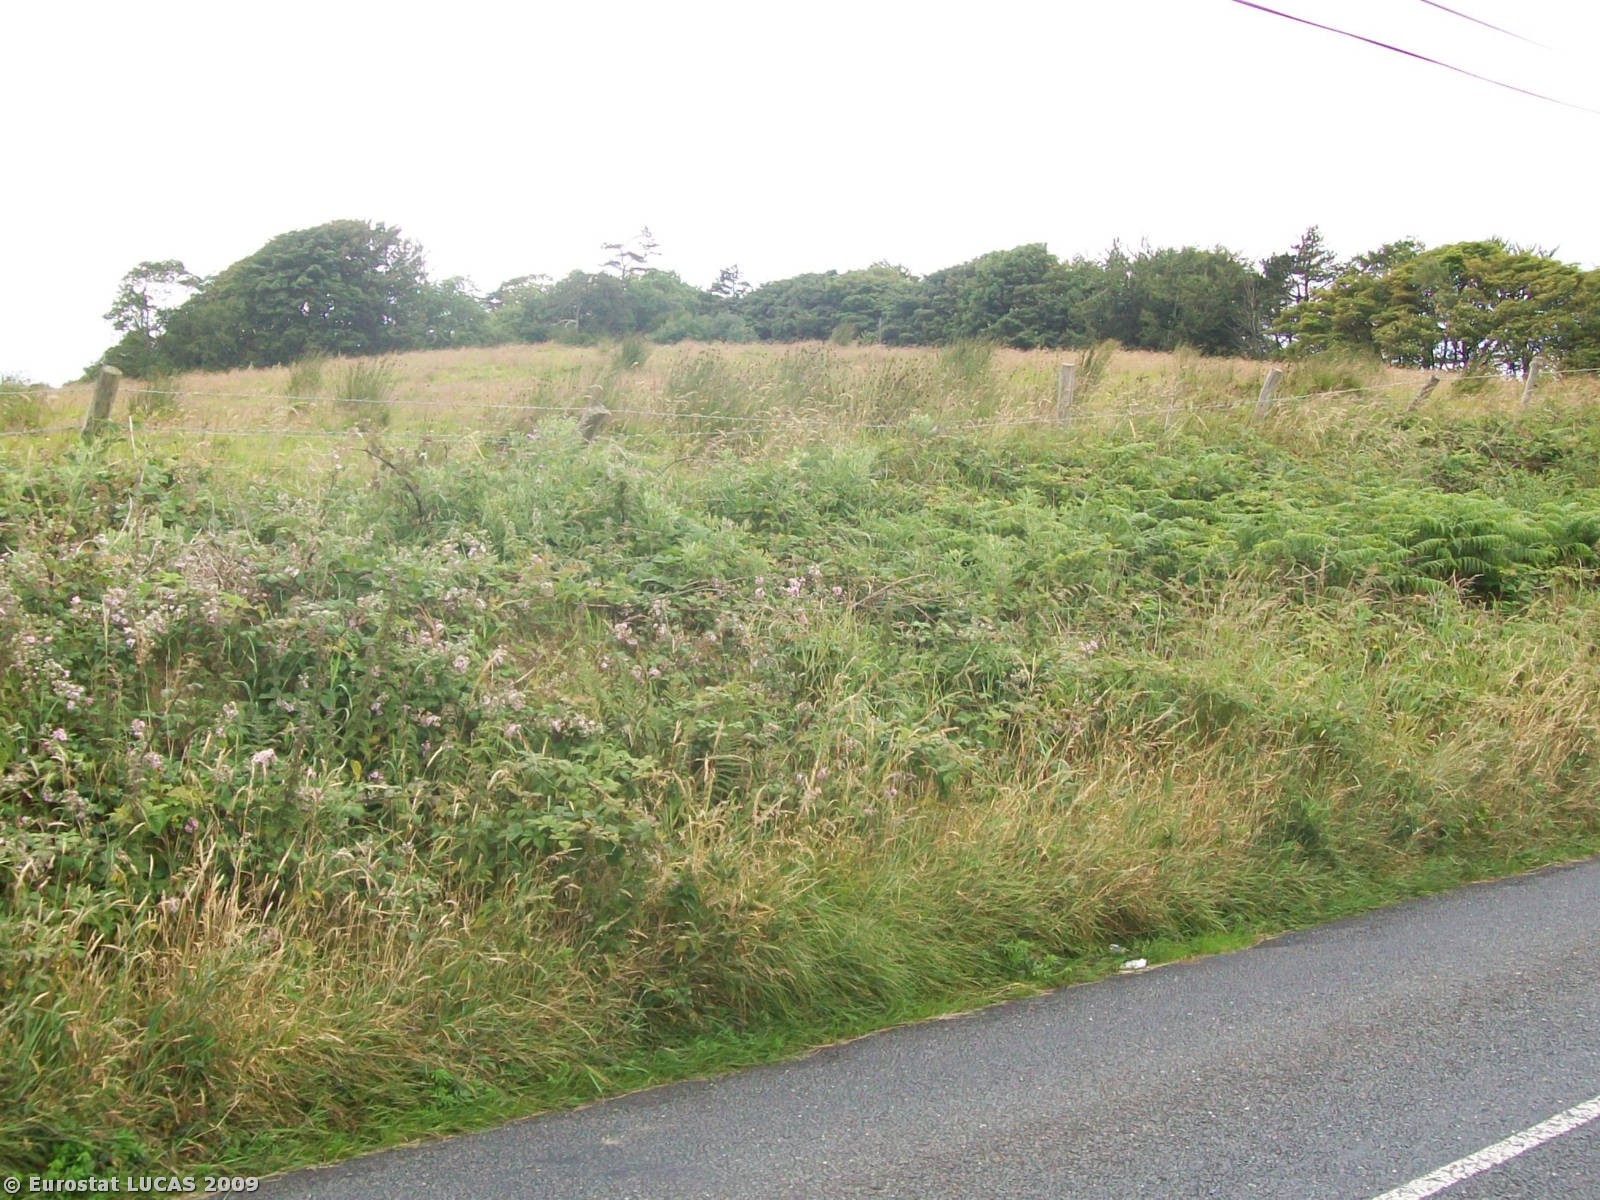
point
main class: Grassland
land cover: Grassland without tree/shrub cover
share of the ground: > 75 %
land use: Agriculture (excluding fallow land and kitchen gardens)
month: July
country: IE
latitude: 54.2369
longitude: -9.2941
